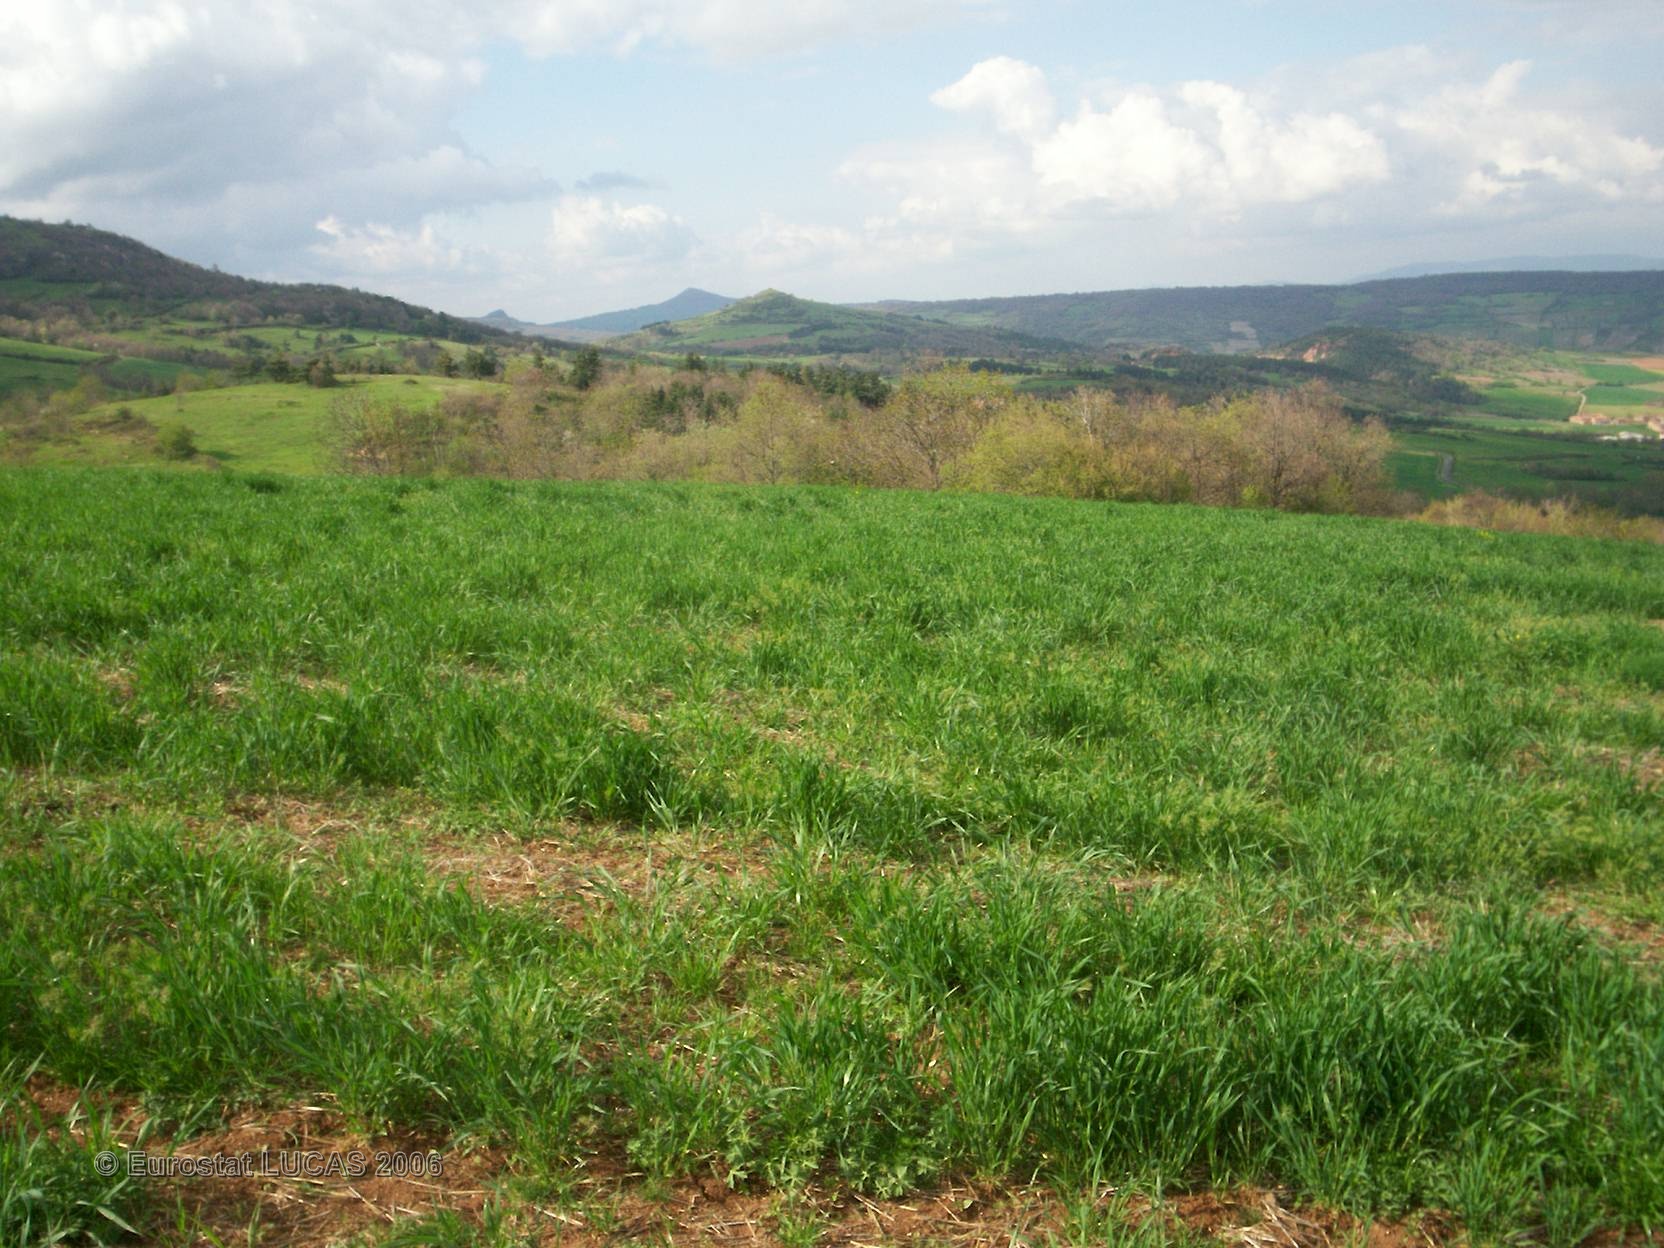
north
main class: Grassland
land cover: Grassland without tree/shrub cover
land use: Agriculture (excluding fallow land and kitchen gardens)
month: April
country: FR
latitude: 45.4273
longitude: 3.1631
